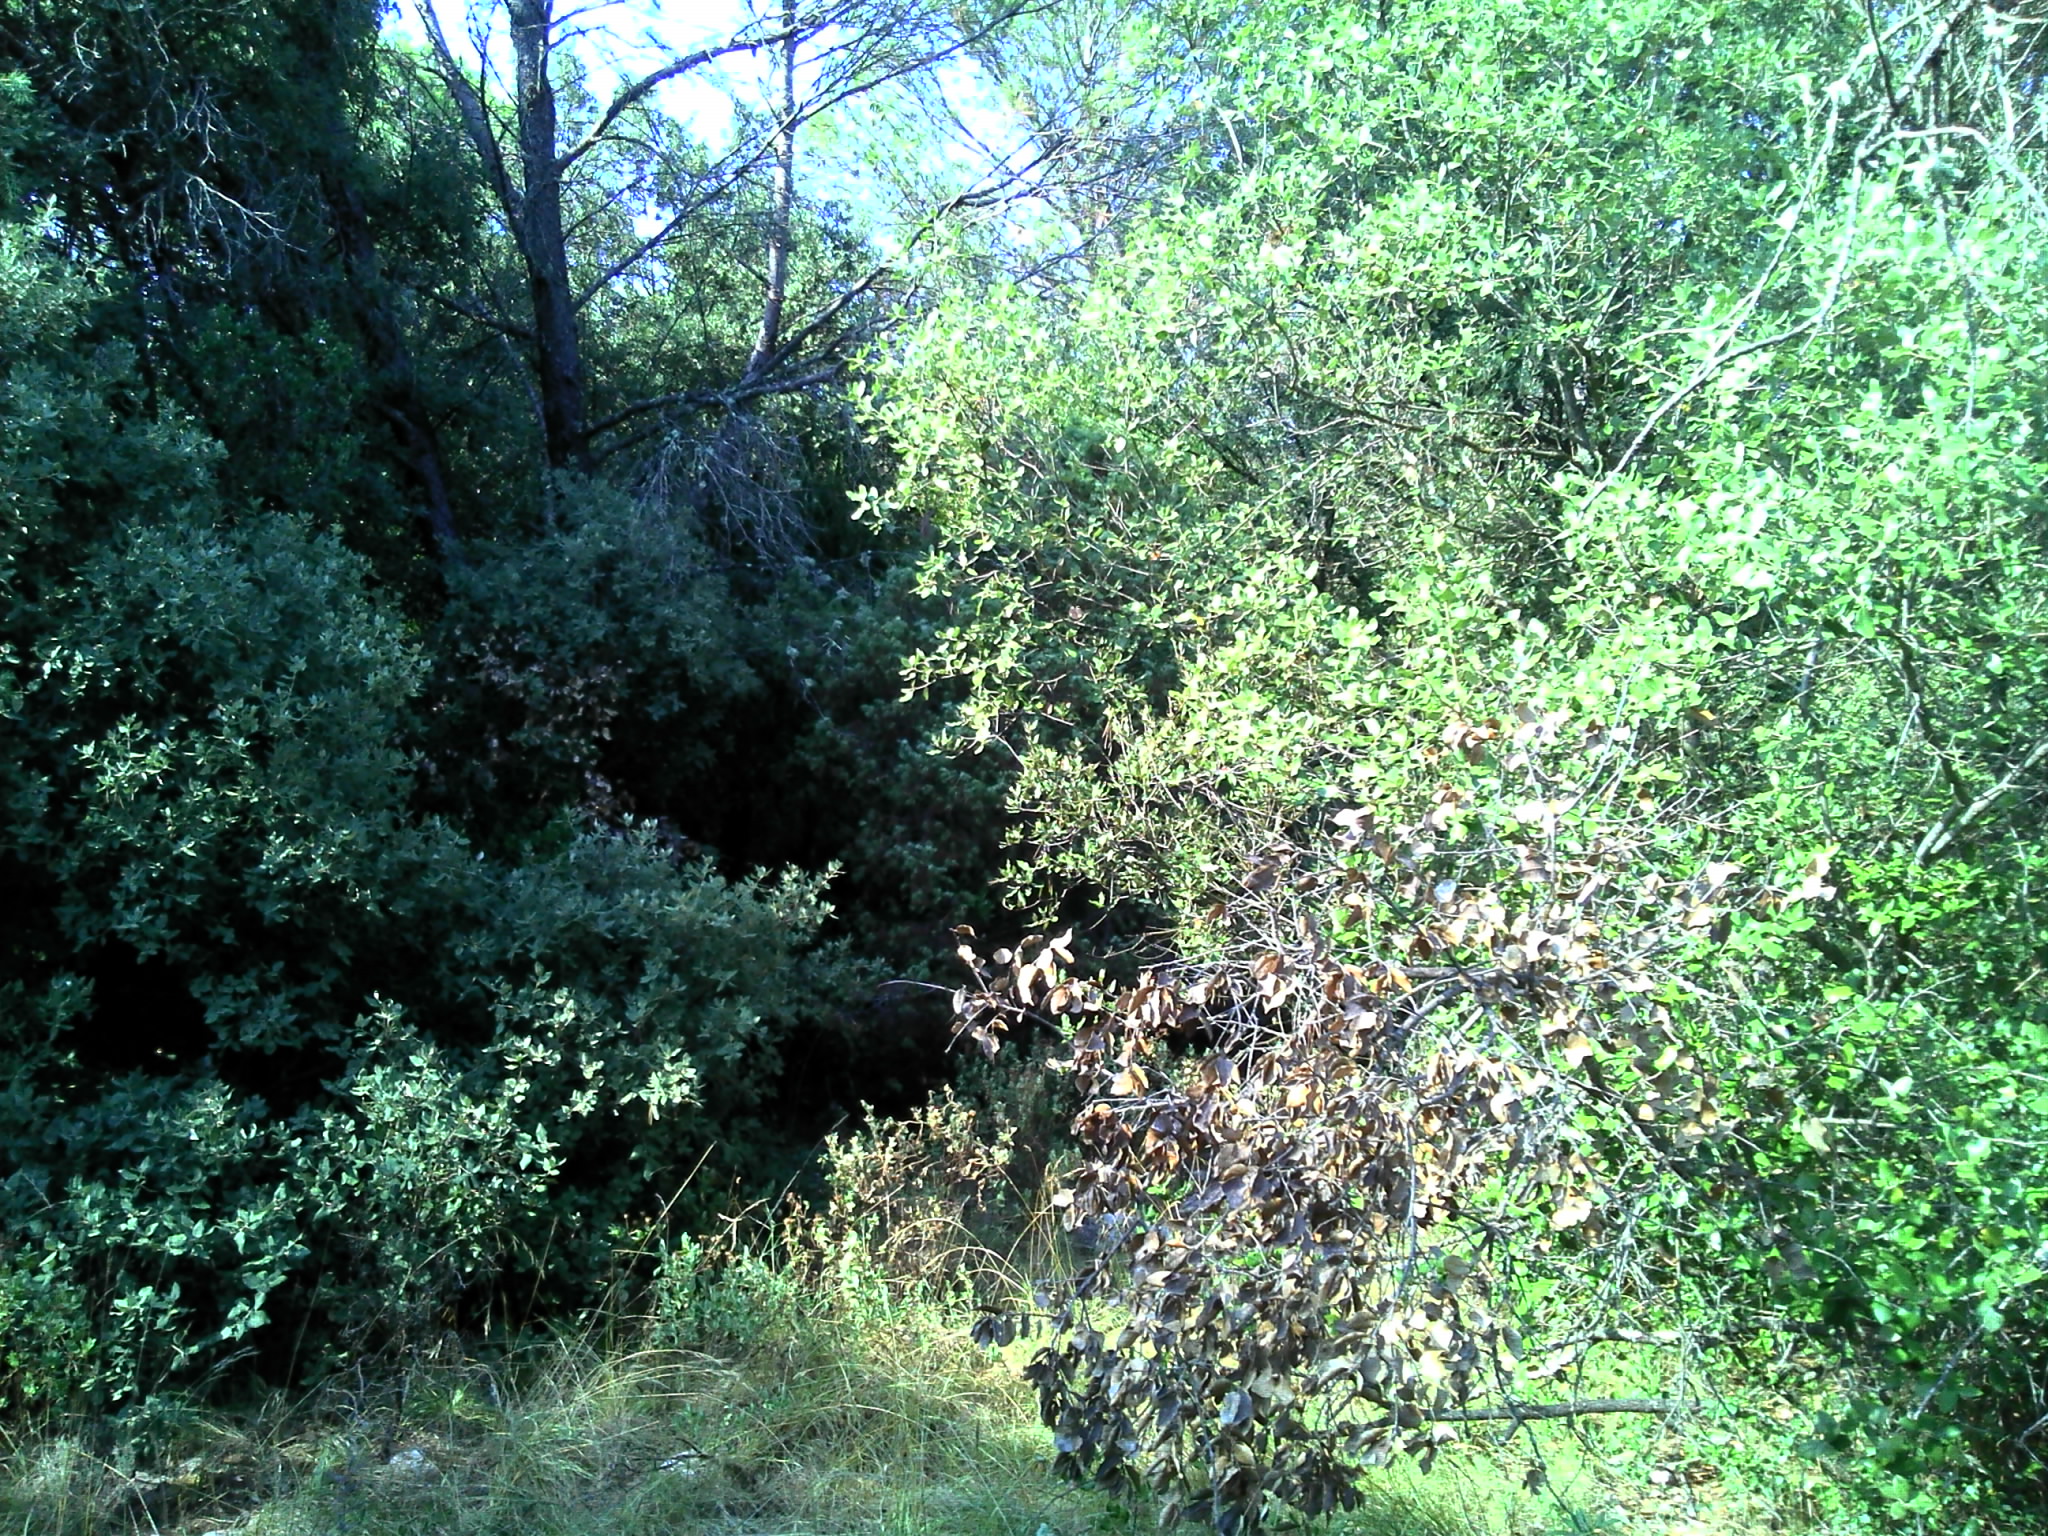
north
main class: Woodland
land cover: Pine dominated mixed woodland
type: coniferous forest of the mediterranean region
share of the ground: > 75 %
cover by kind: broadleaved forest trees 40 %, coniferous forest trees 30 %, herbaceous plants 20 %, shrubs 5 %, consolidated bare surface 5 %
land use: Semi-natural and natural areas not in use
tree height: > 5 m
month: August
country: FR
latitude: 44.0308
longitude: 4.6305
